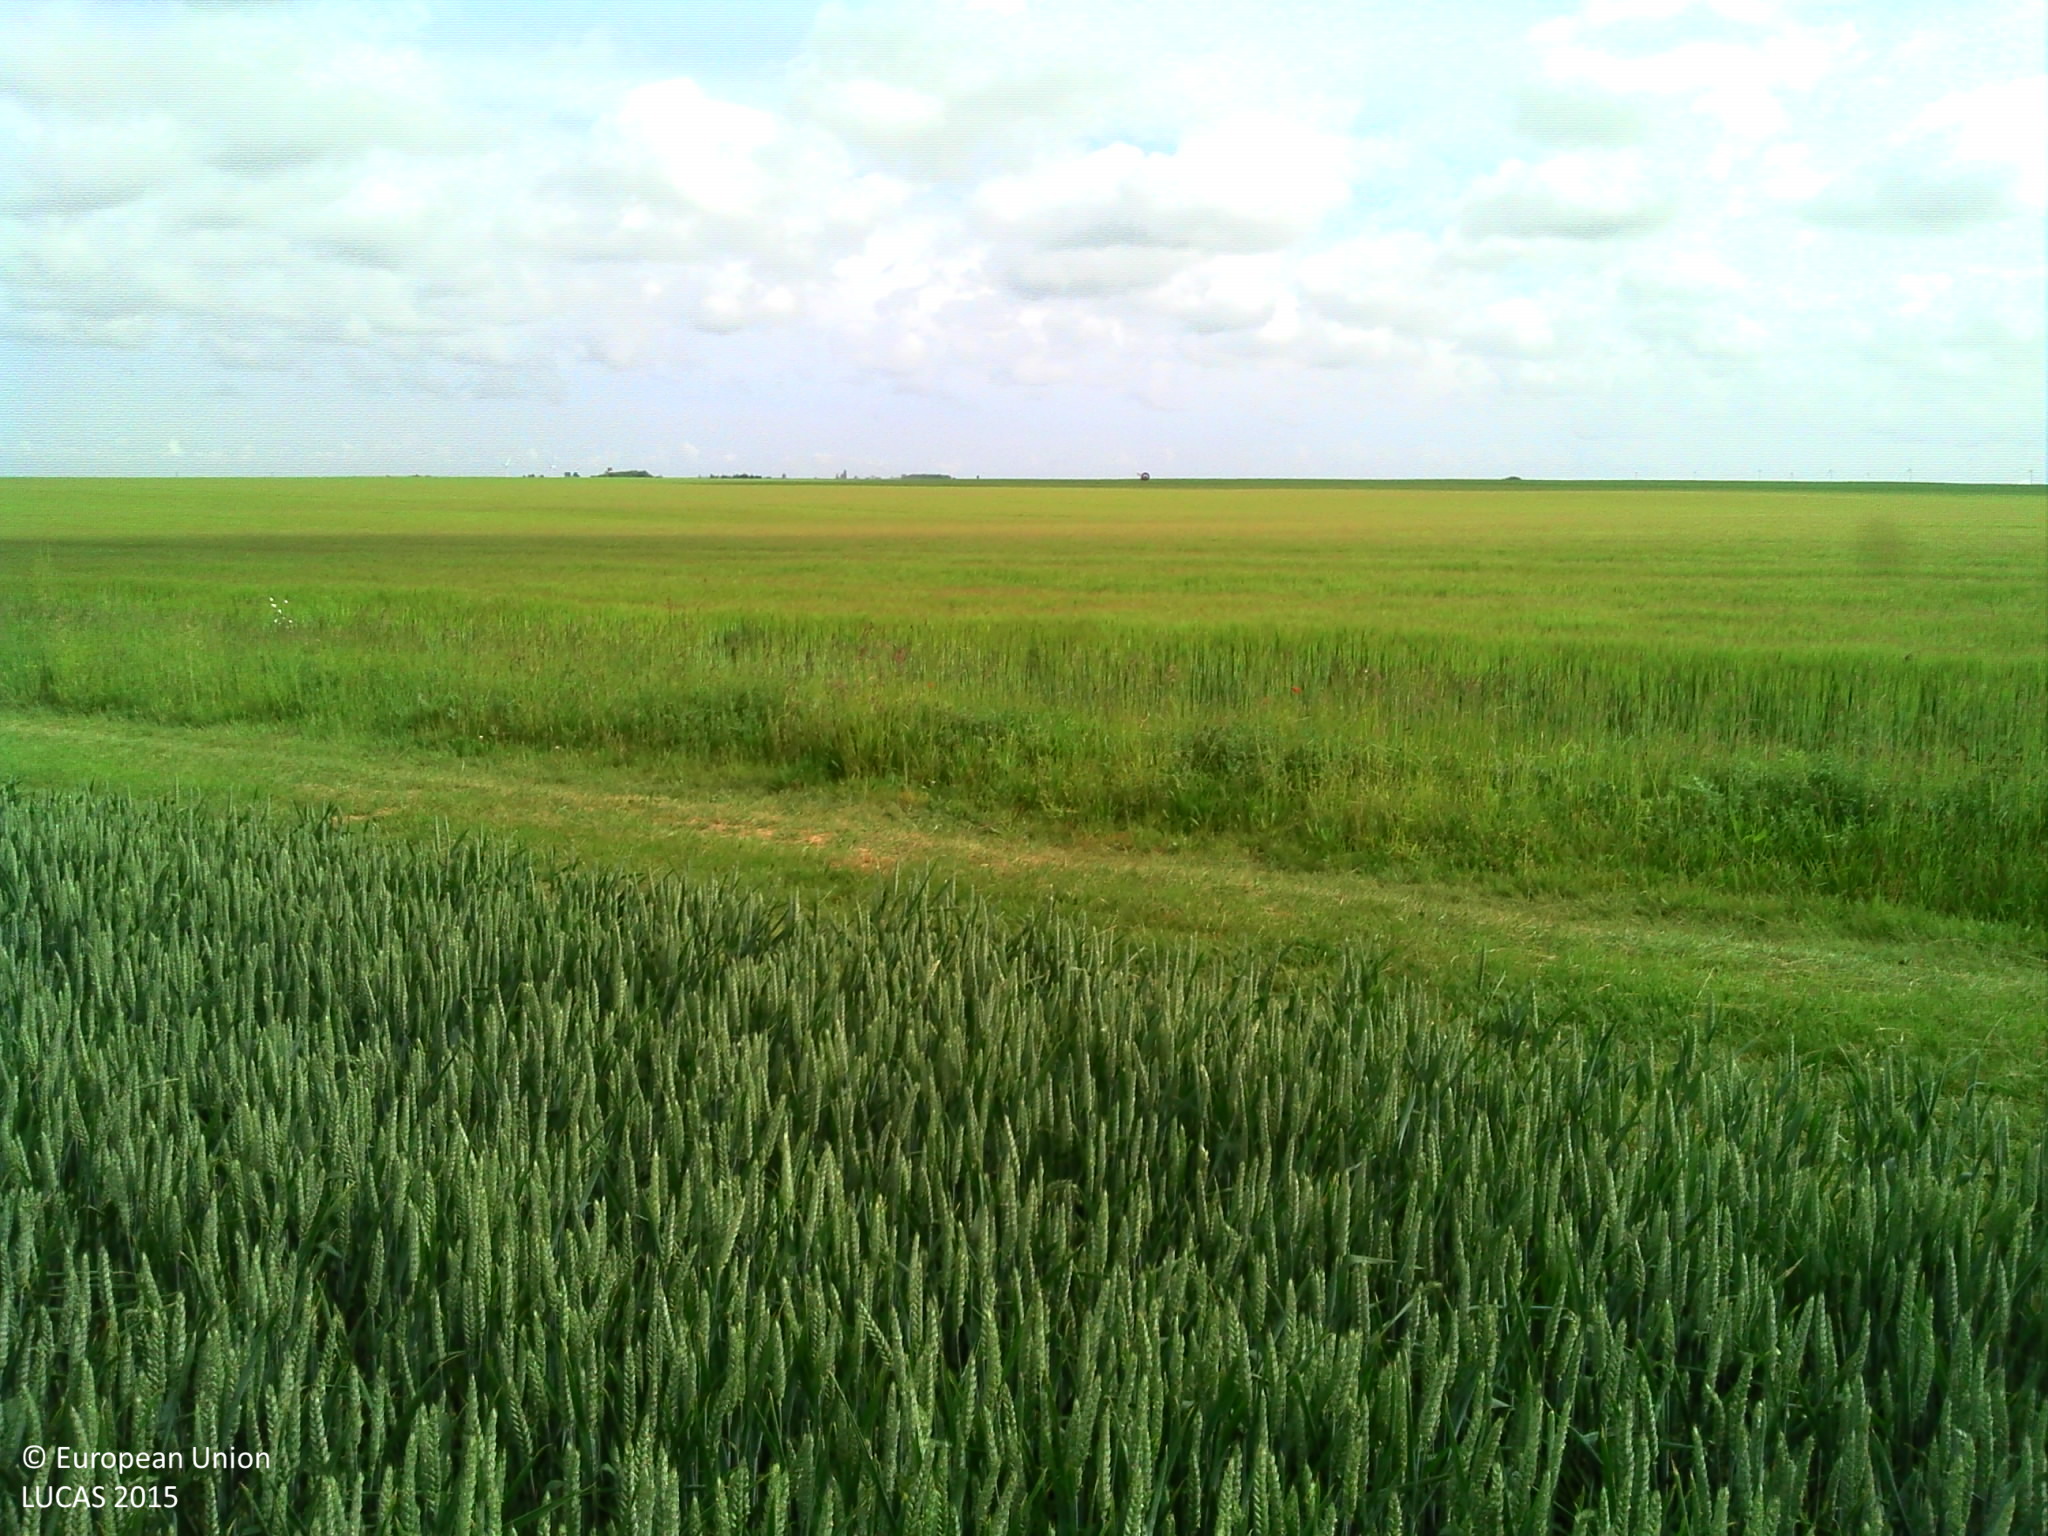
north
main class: Cropland
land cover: Common wheat
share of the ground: > 75 %
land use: Agriculture (excluding fallow land and kitchen gardens)
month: June
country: FR
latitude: 48.3057
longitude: 1.9105
